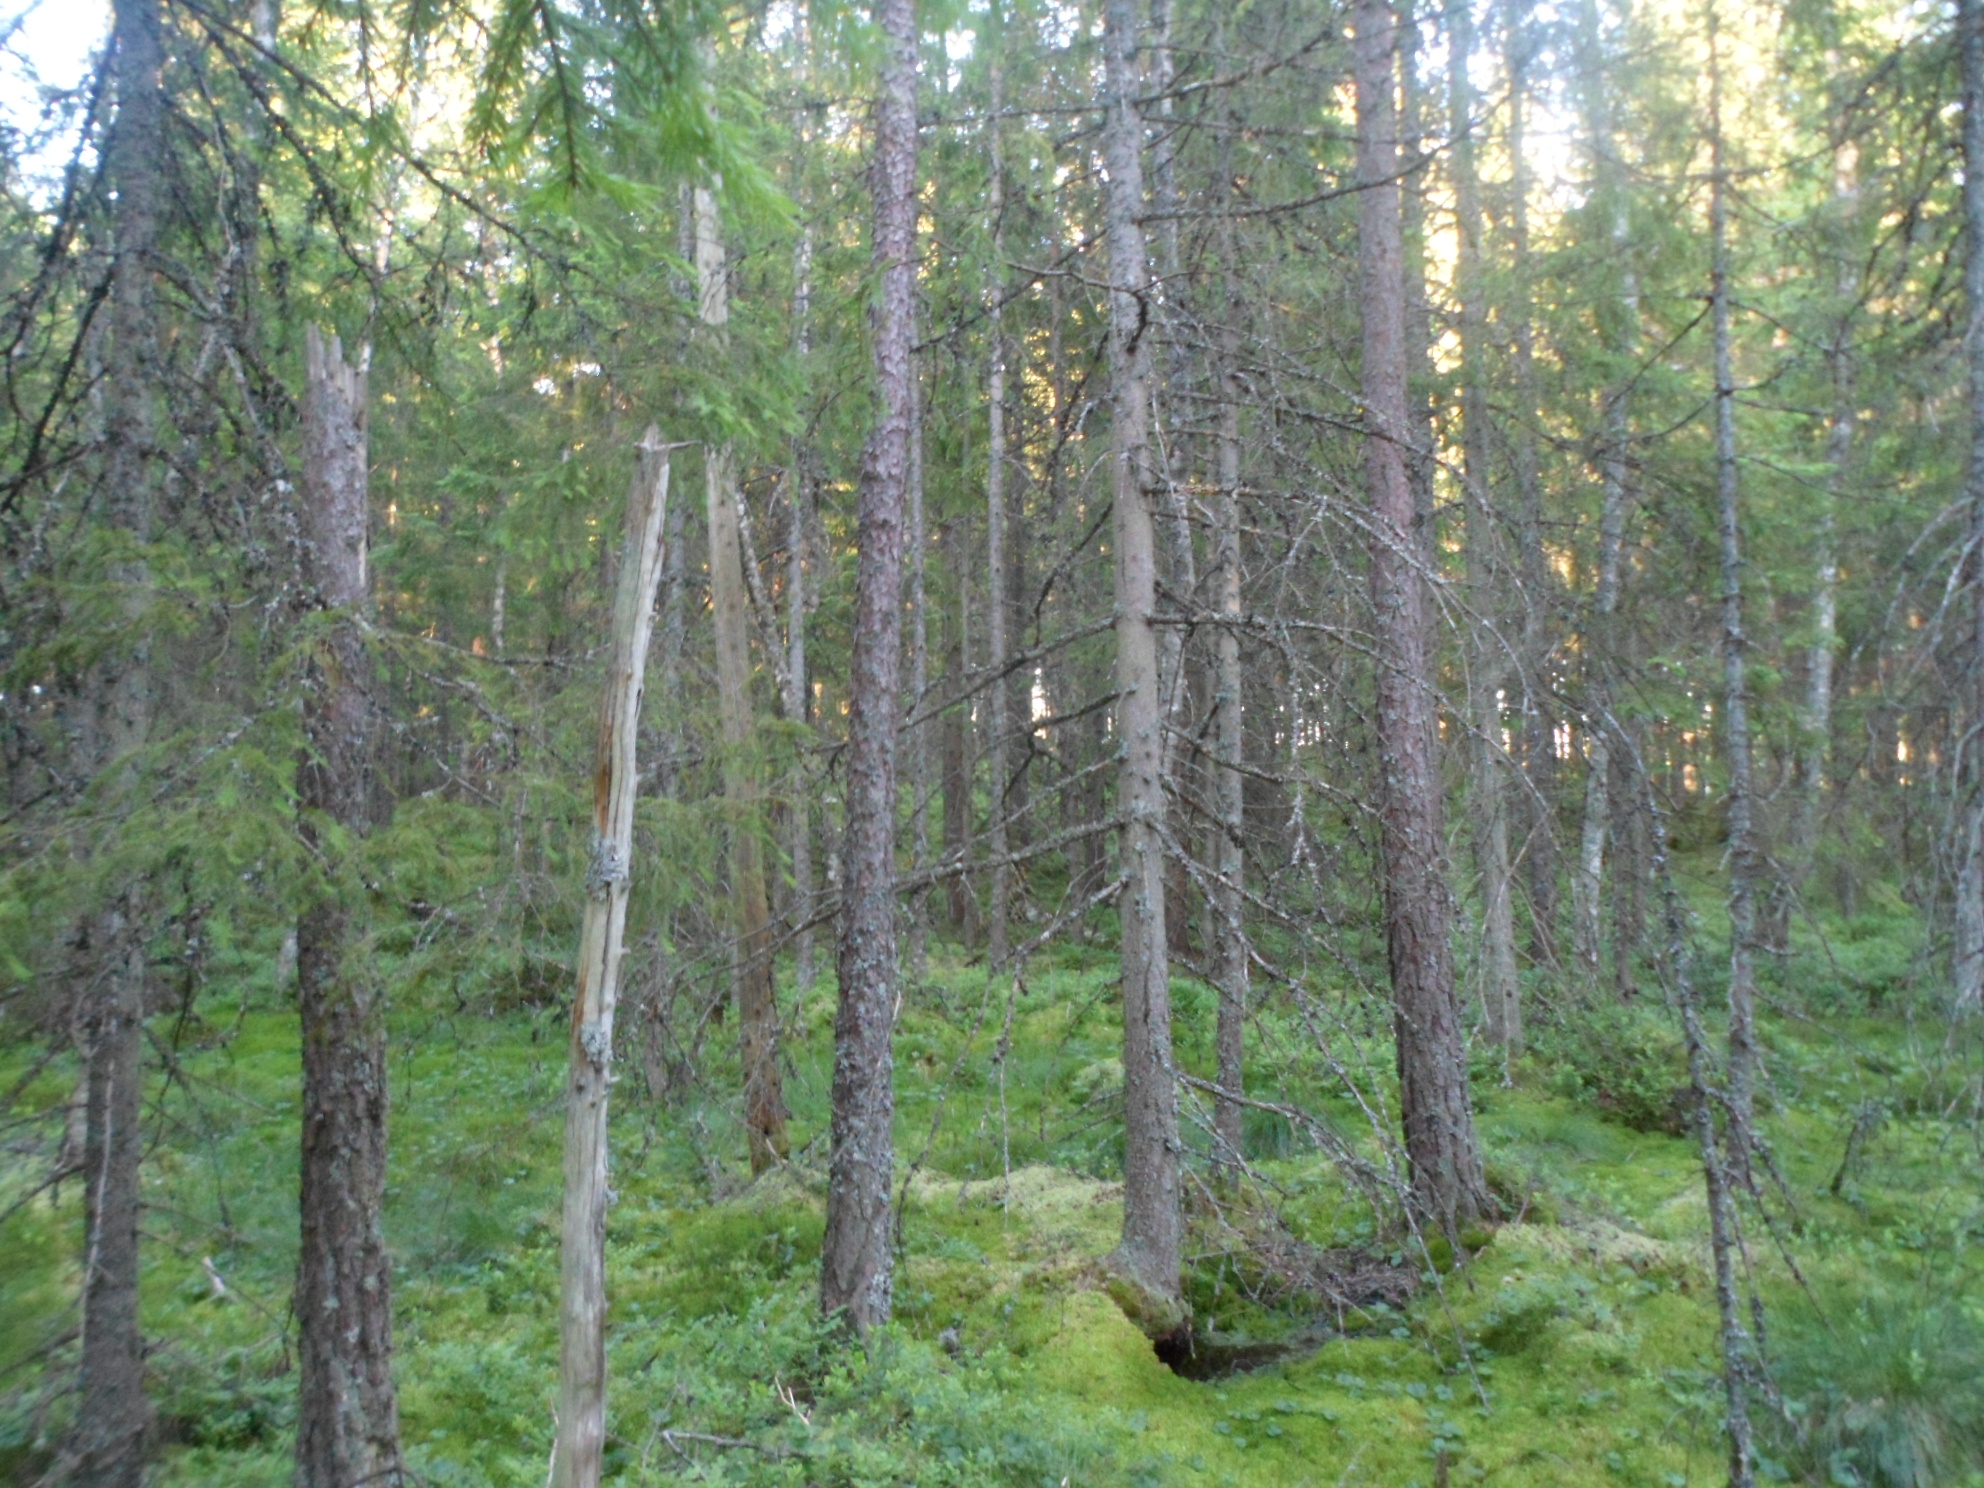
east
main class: Woodland
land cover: Pine dominated coniferous woodland
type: boreal forest
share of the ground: 50 - 75 %
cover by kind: coniferous forest trees 50 %, lichens and mosses 25 %, broadleaved forest trees 10 %, shrubs 10 %, herbaceous plants 5 %
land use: Forestry
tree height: > 5 m
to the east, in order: Pine dominated coniferous woodland; Spruce dominated coniferous woodland; Broadleaved woodland; Spruce dominated mixed woodland
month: July
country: SE
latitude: 57.5164
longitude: 14.4197
